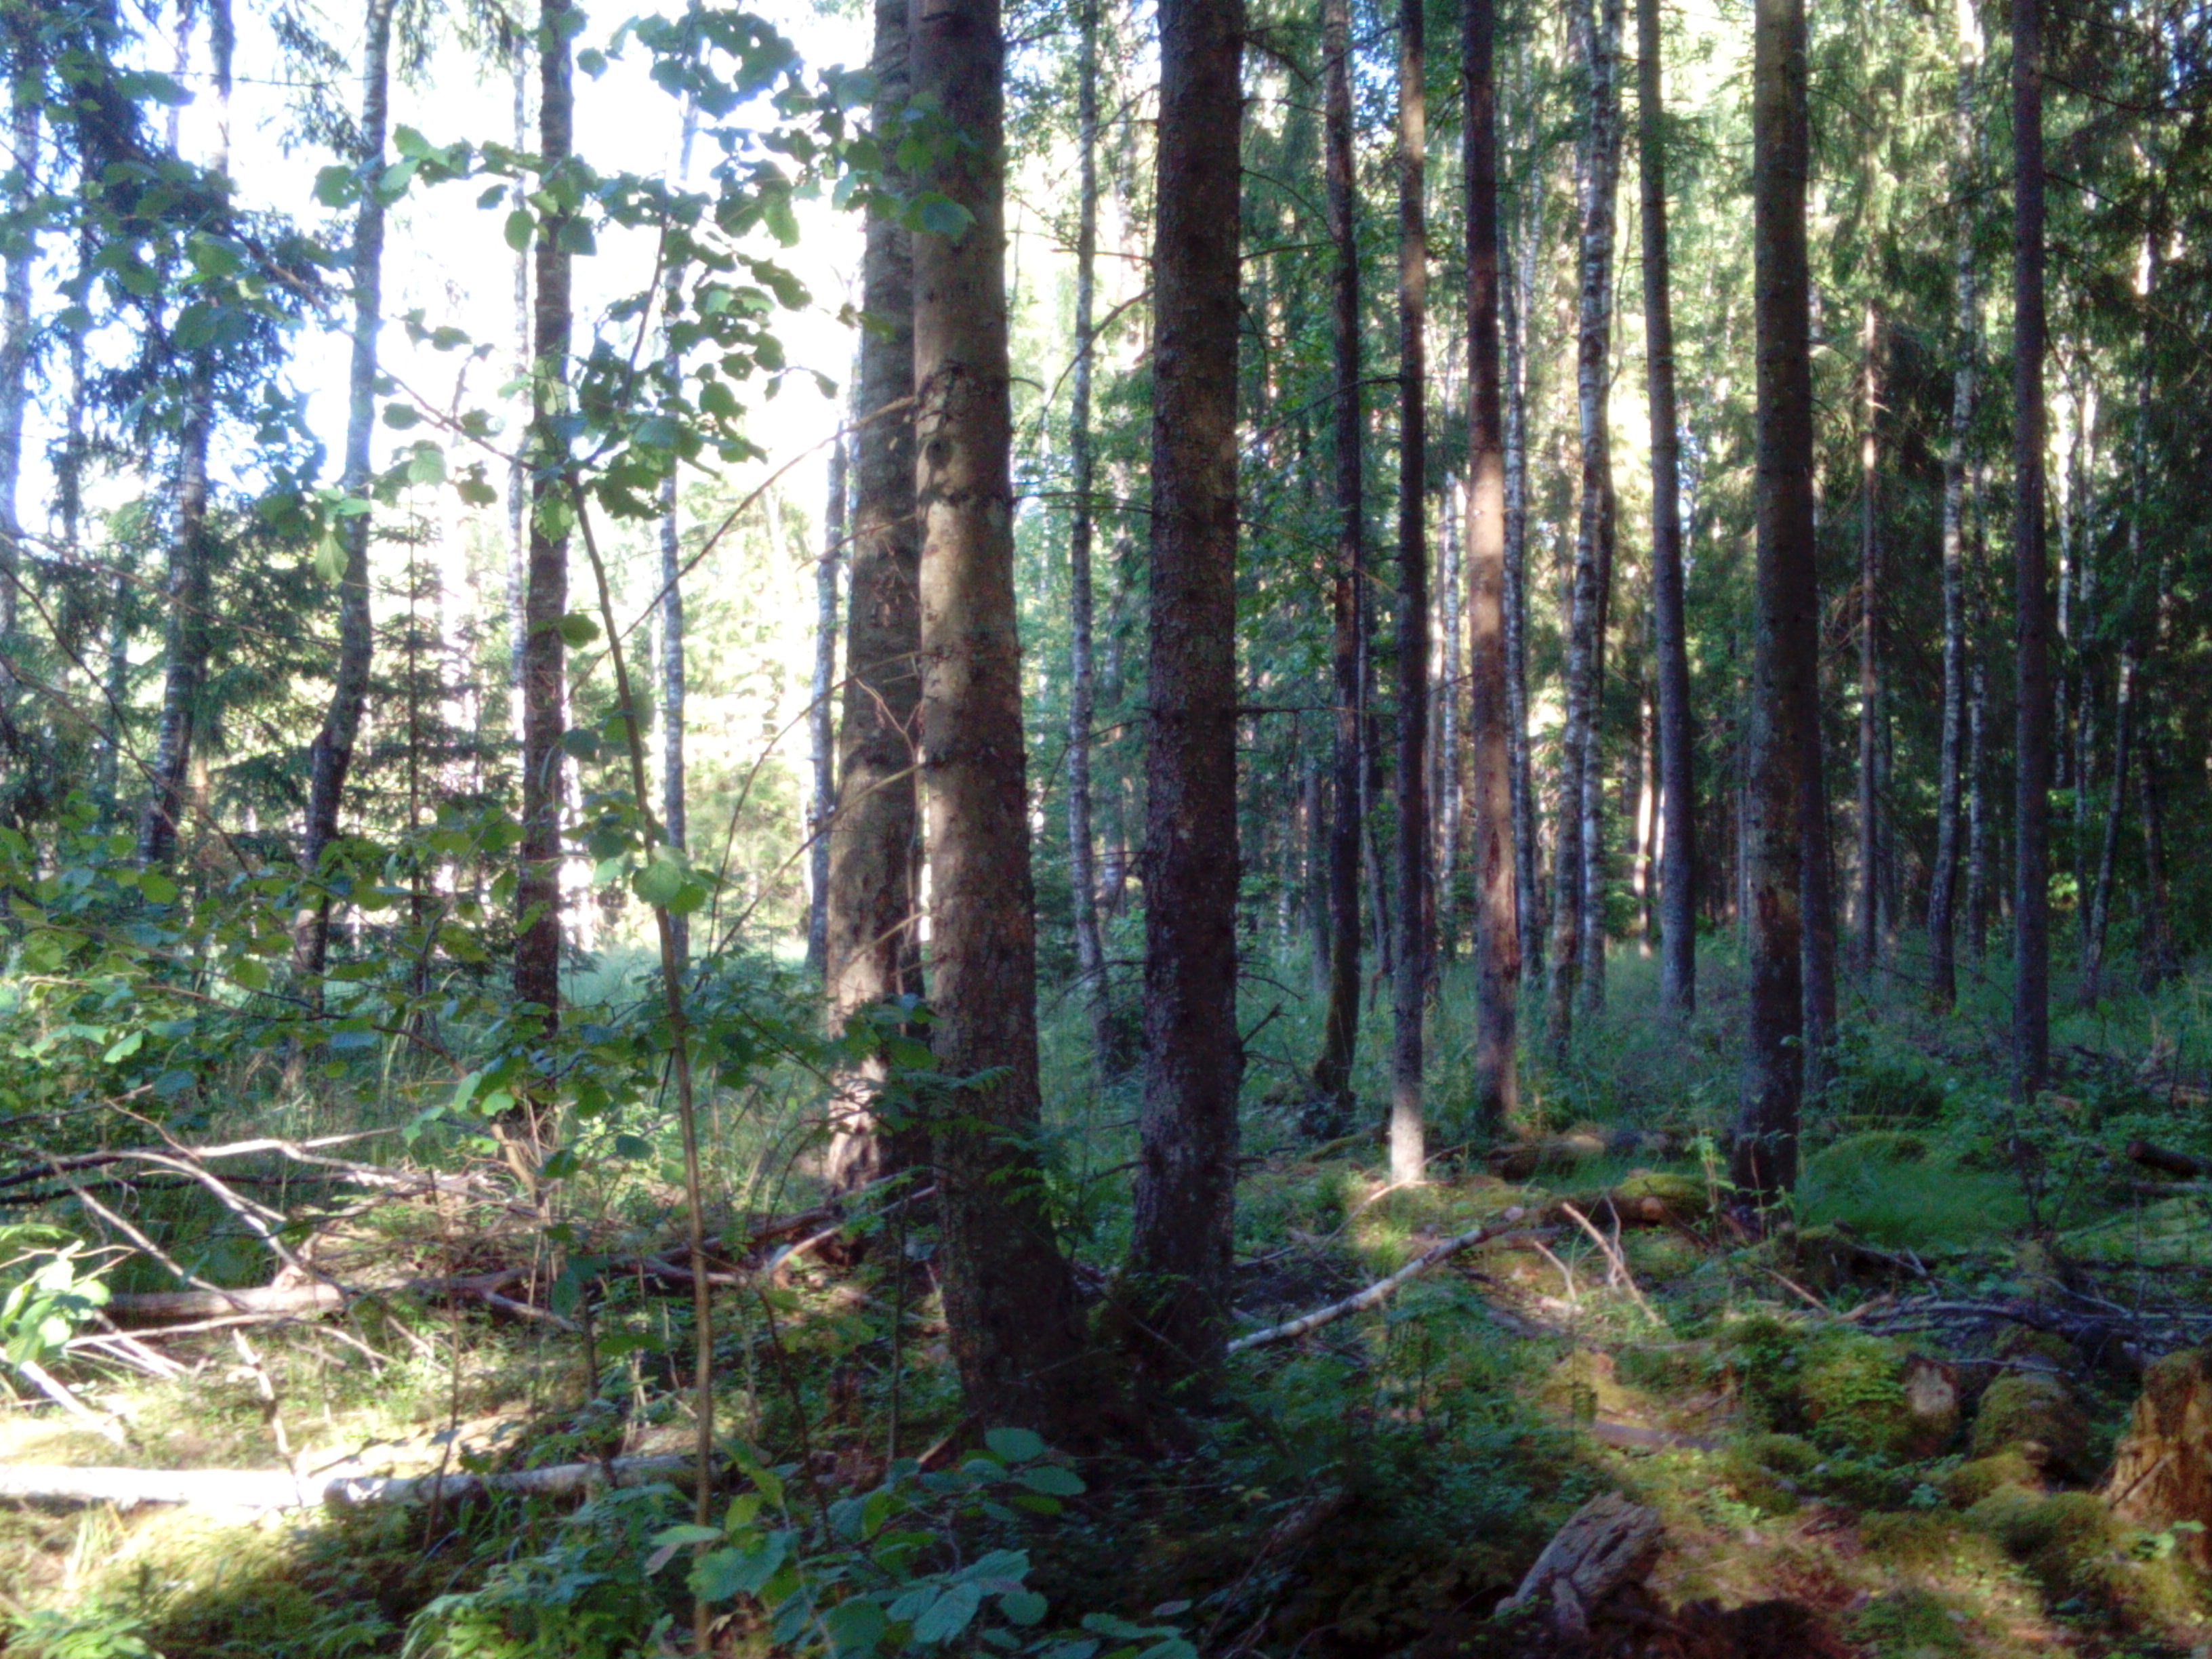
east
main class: Woodland
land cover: Spruce dominated mixed woodland
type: hemiboreal forest and nemoral coniferous forest and mixed broadleaved-coniferous forest
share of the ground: > 75 %
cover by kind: coniferous forest trees 60 %, broadleaved forest trees 25 %, herbaceous plants 10 %, lichens and mosses 5 %
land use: Forestry
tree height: > 5 m
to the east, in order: Spruce dominated mixed woodland; Grassland with sparse tree/shrub cover; Spruce dominated mixed woodland
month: July
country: LV
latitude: 56.5349
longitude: 22.1657
